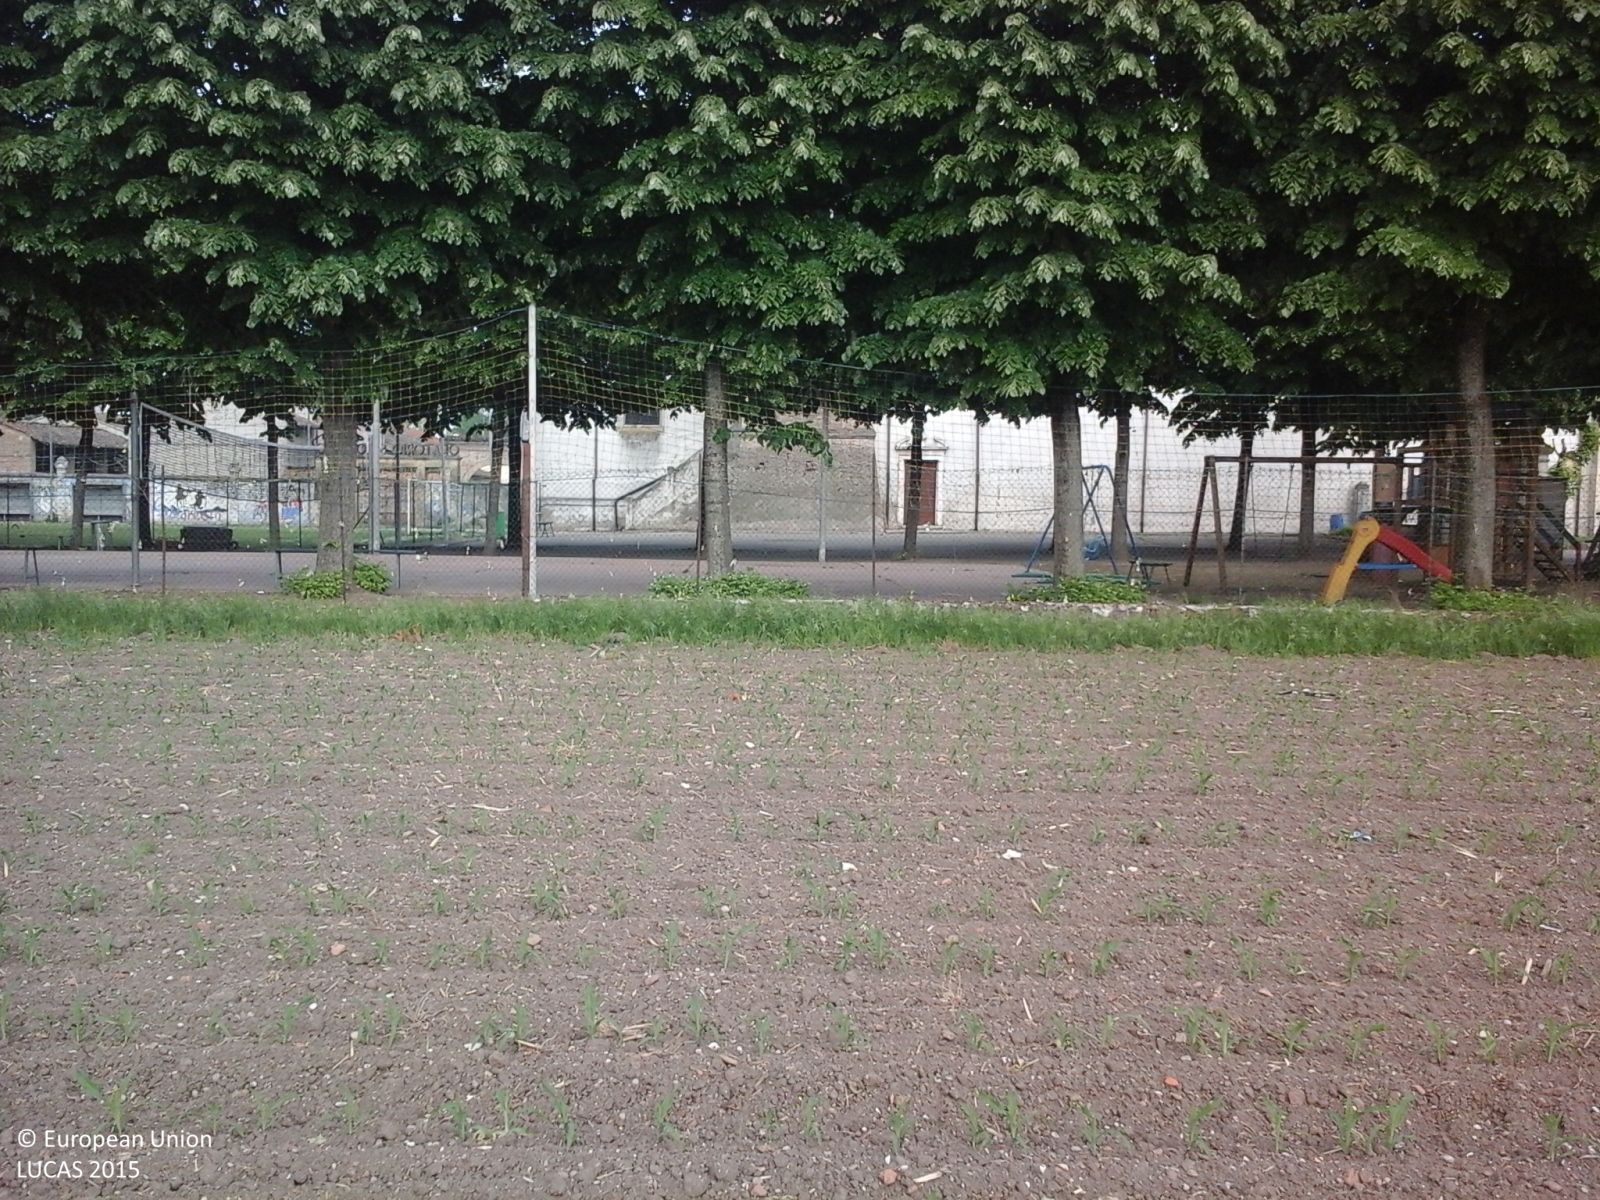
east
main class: Cropland
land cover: Maize
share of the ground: > 75 %
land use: Agriculture (excluding fallow land and kitchen gardens)
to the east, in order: Maize; Artificial constructions in urban areas
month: May
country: IT
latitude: 45.2336
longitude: 10.3178
